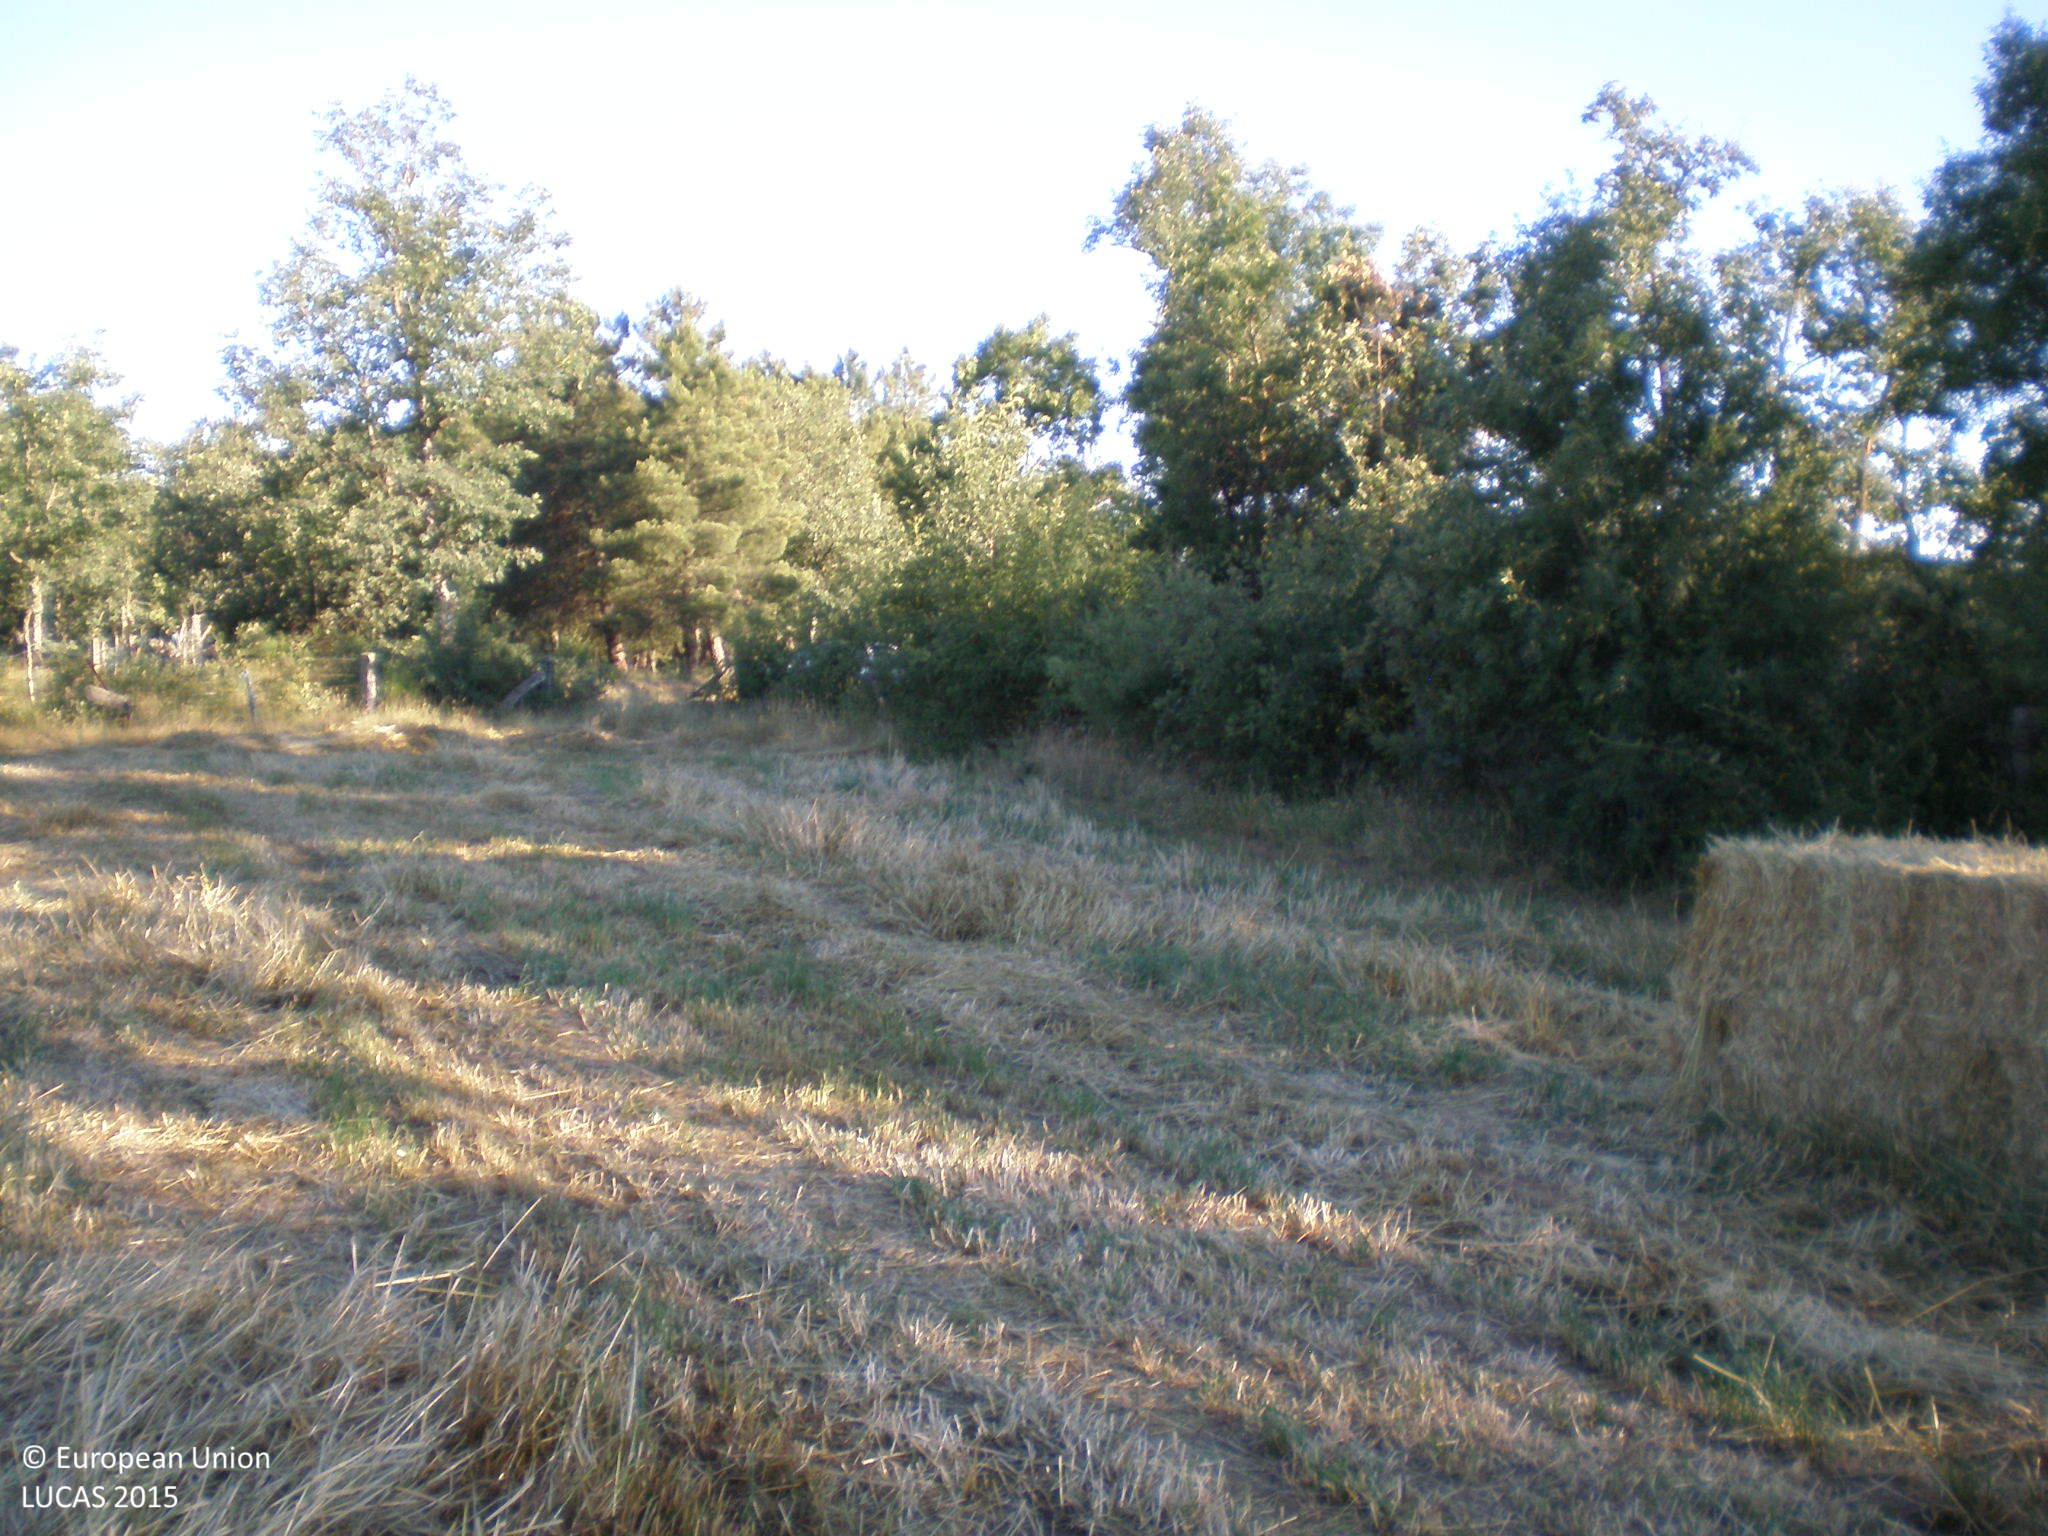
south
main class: Cropland
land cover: Mixed cereals for fodder
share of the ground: < 10 %
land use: Agriculture (excluding fallow land and kitchen gardens)
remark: Harvested field
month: June
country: ES
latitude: 40.5744
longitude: -5.8211
